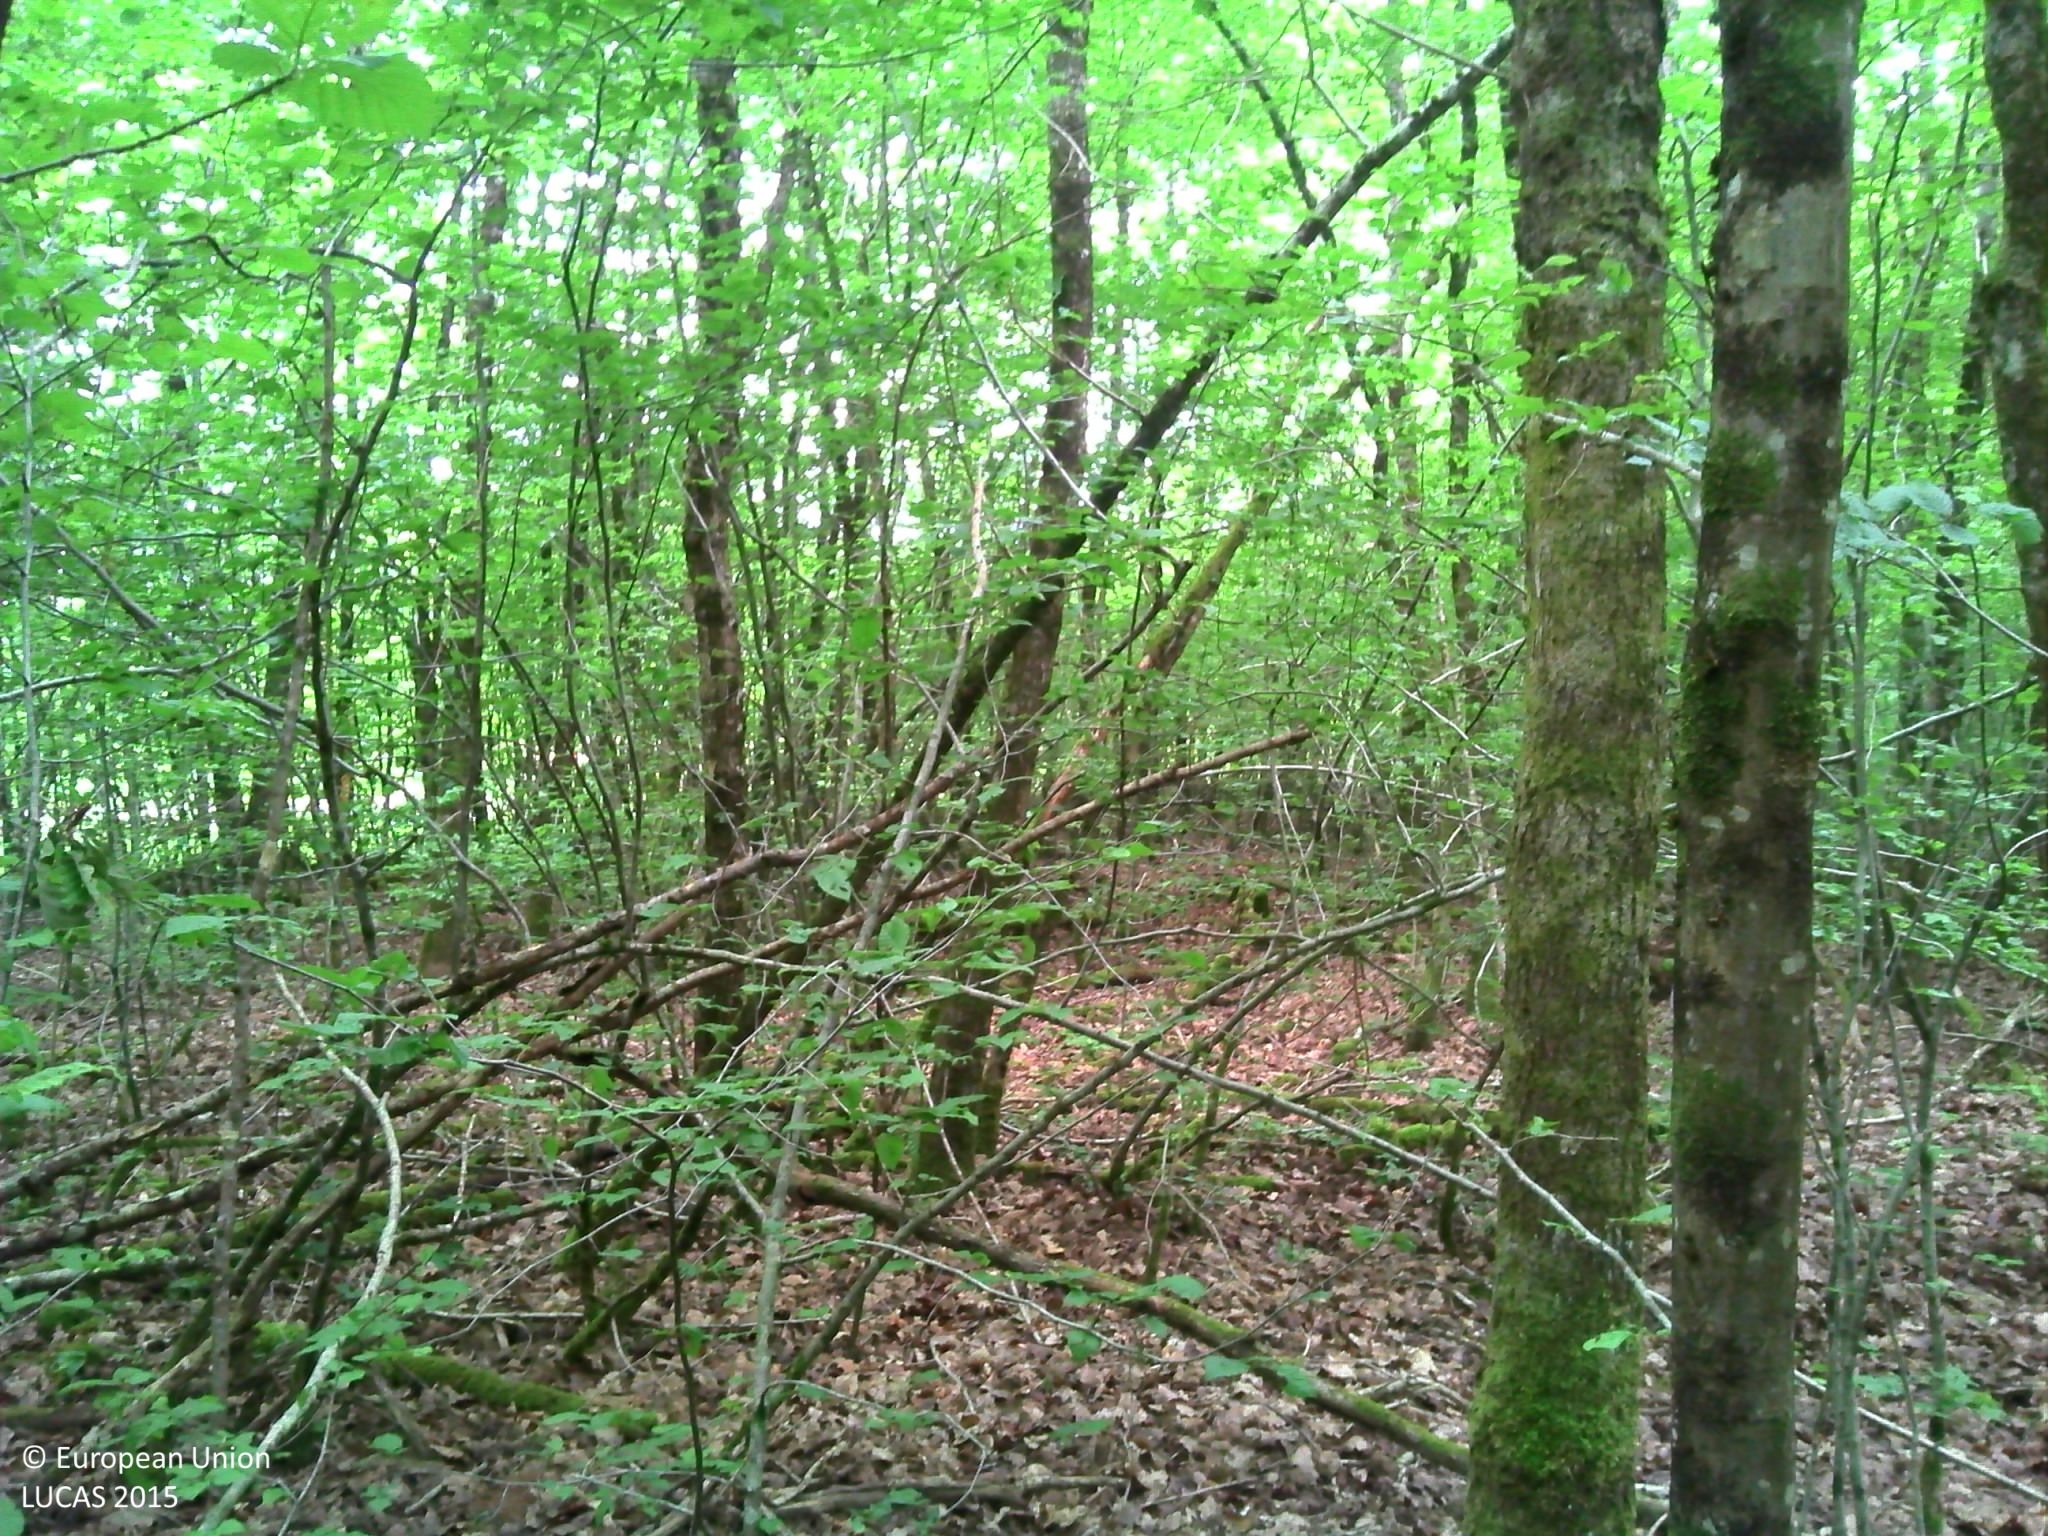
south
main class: Woodland
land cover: Broadleaved woodland
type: beech forest
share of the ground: > 75 %
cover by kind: broadleaved forest trees 95 %, herbaceous plants 5 %
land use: Forestry
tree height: > 5 m
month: May
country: FR
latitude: 47.9271
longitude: 6.2936
